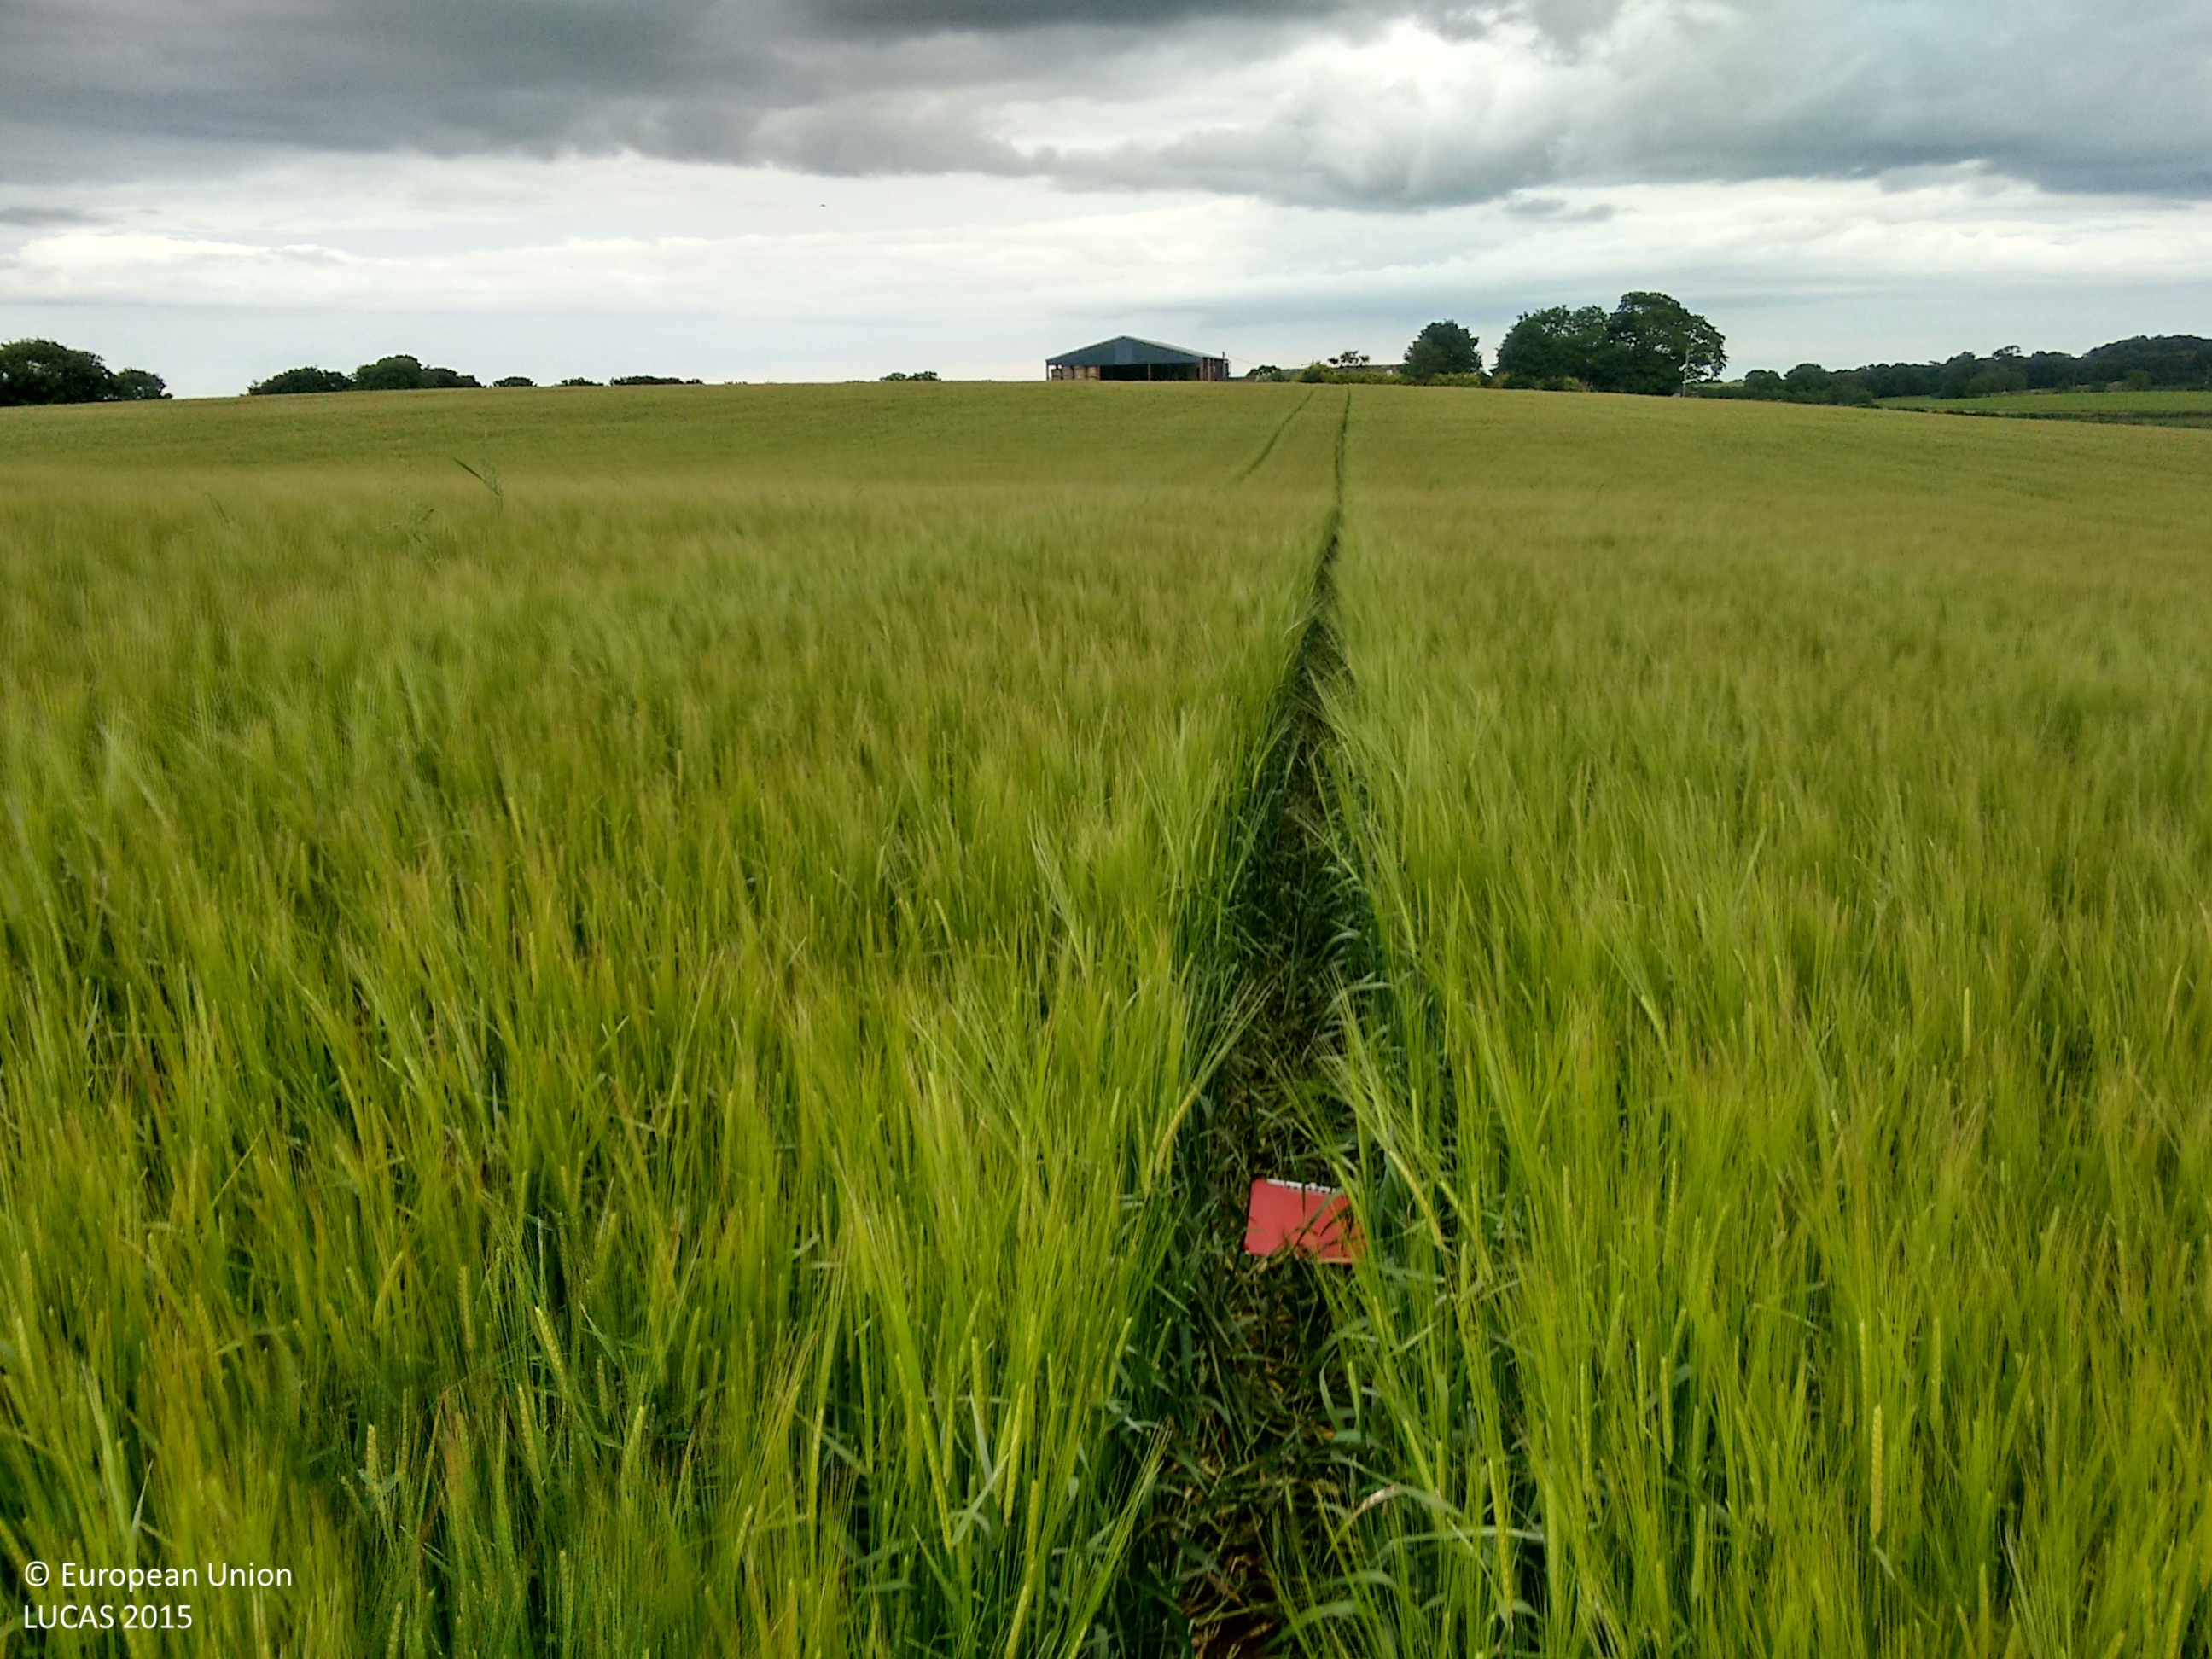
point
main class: Cropland
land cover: Barley
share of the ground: > 75 %
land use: Agriculture (excluding fallow land and kitchen gardens)
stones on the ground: < 10 %
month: July
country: GB
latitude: 57.6234
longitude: -2.0165
